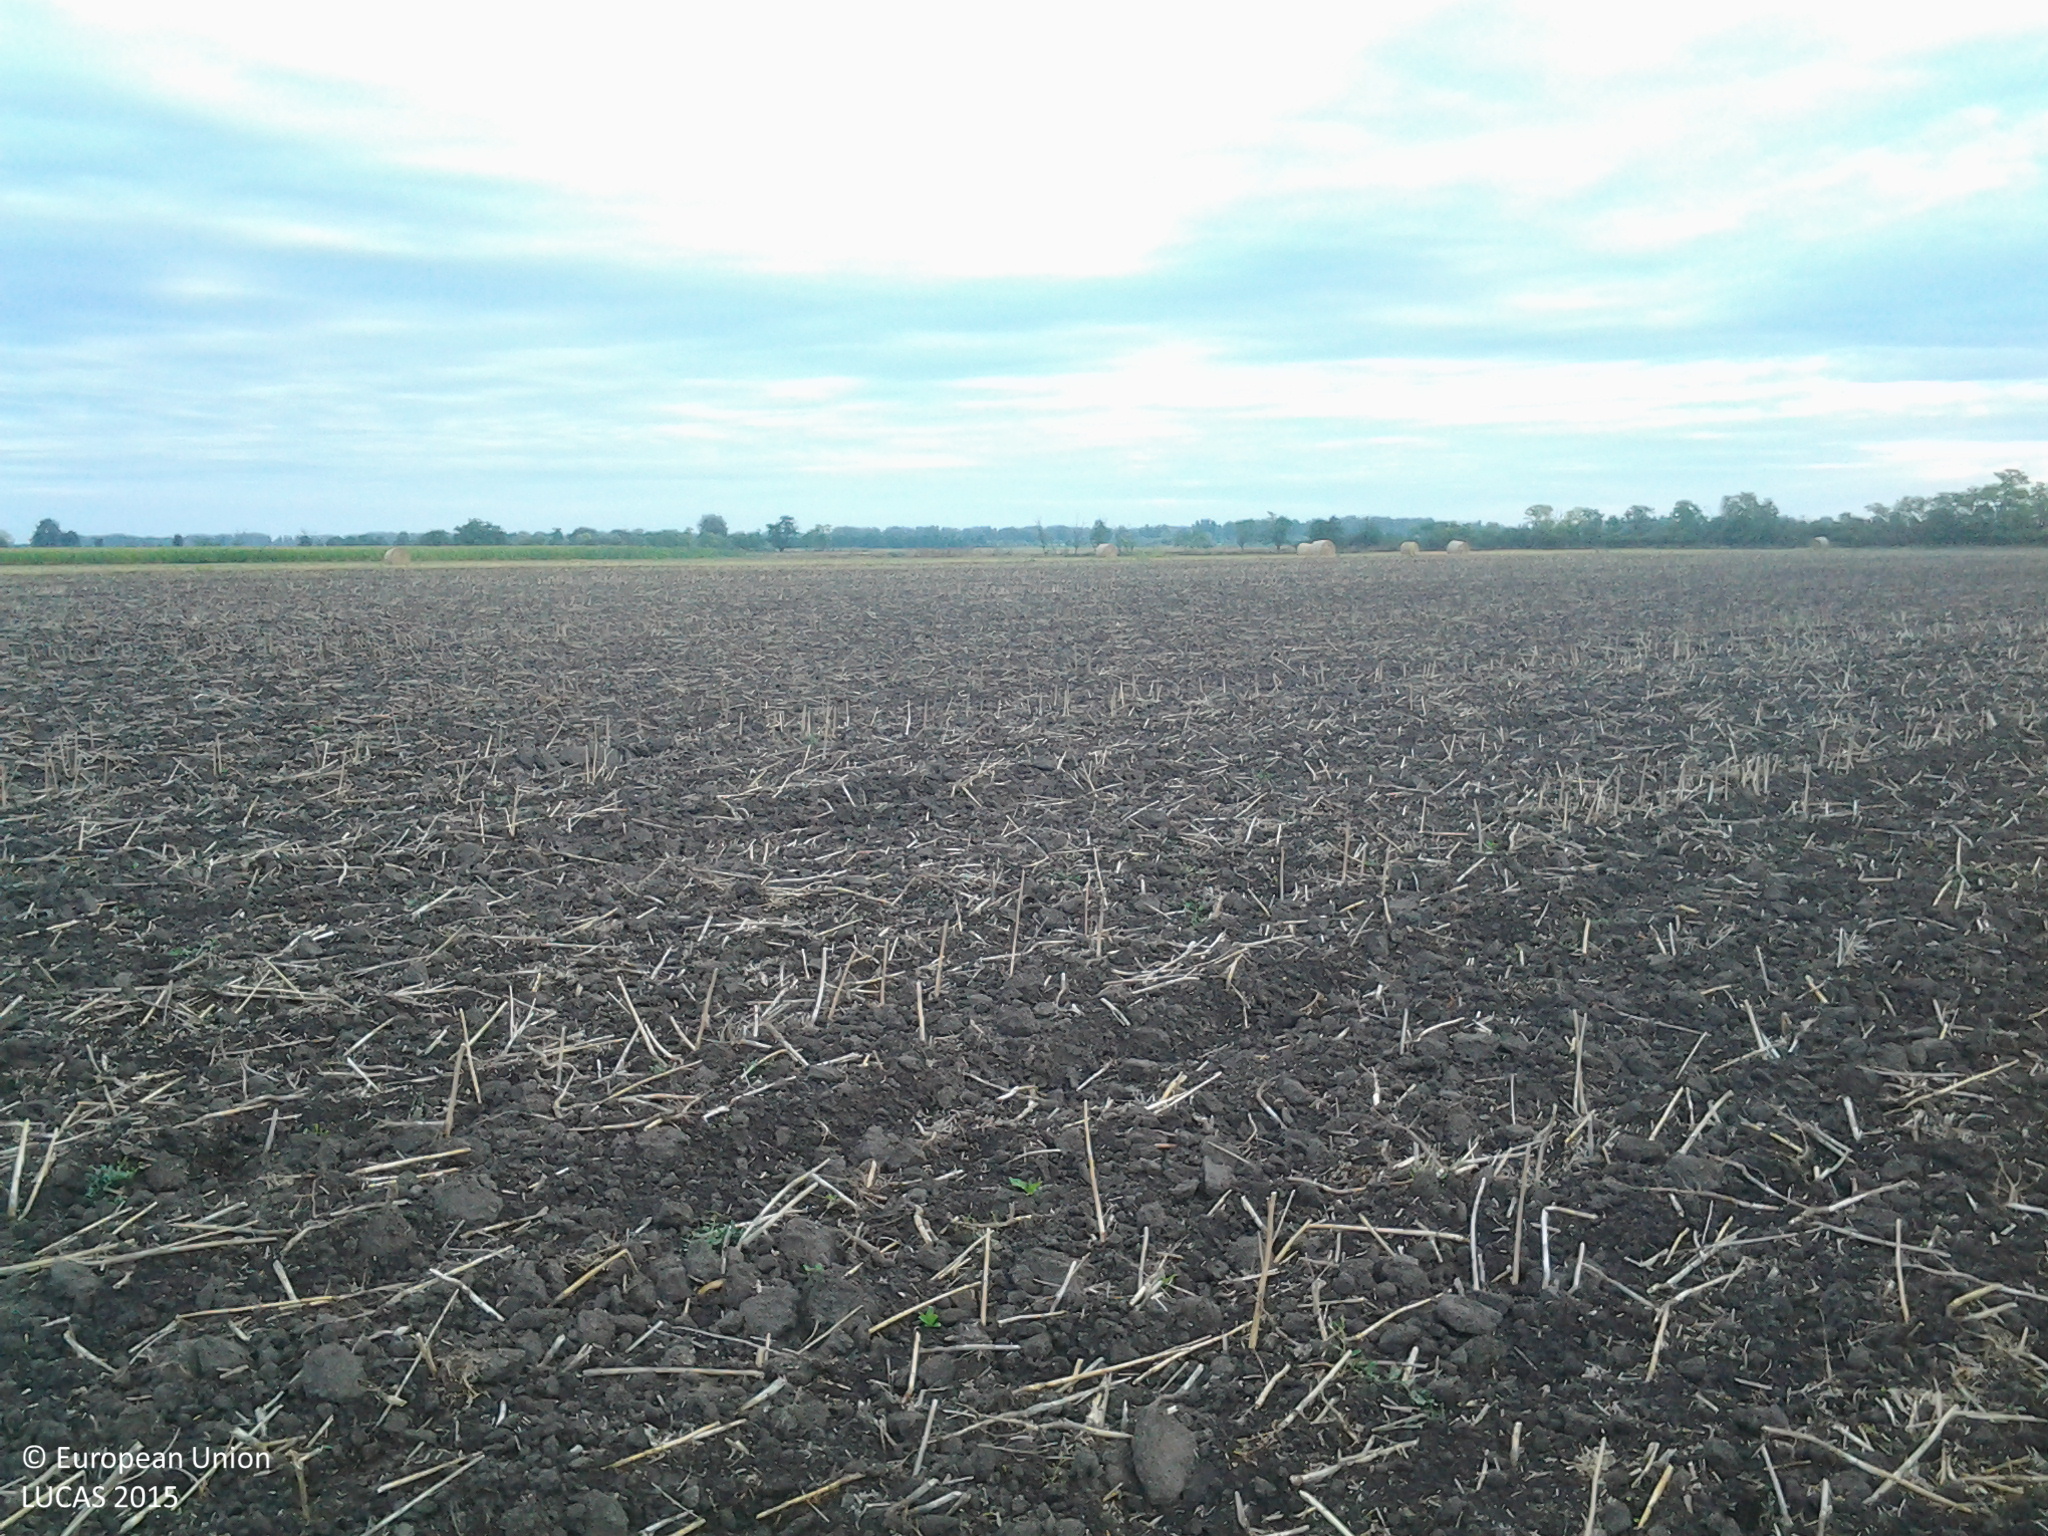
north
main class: Cropland
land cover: Rape and turnip rape
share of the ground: < 10 %
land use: Agriculture (excluding fallow land and kitchen gardens)
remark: Harvested field
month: July
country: HU
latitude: 46.9794
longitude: 19.0737
